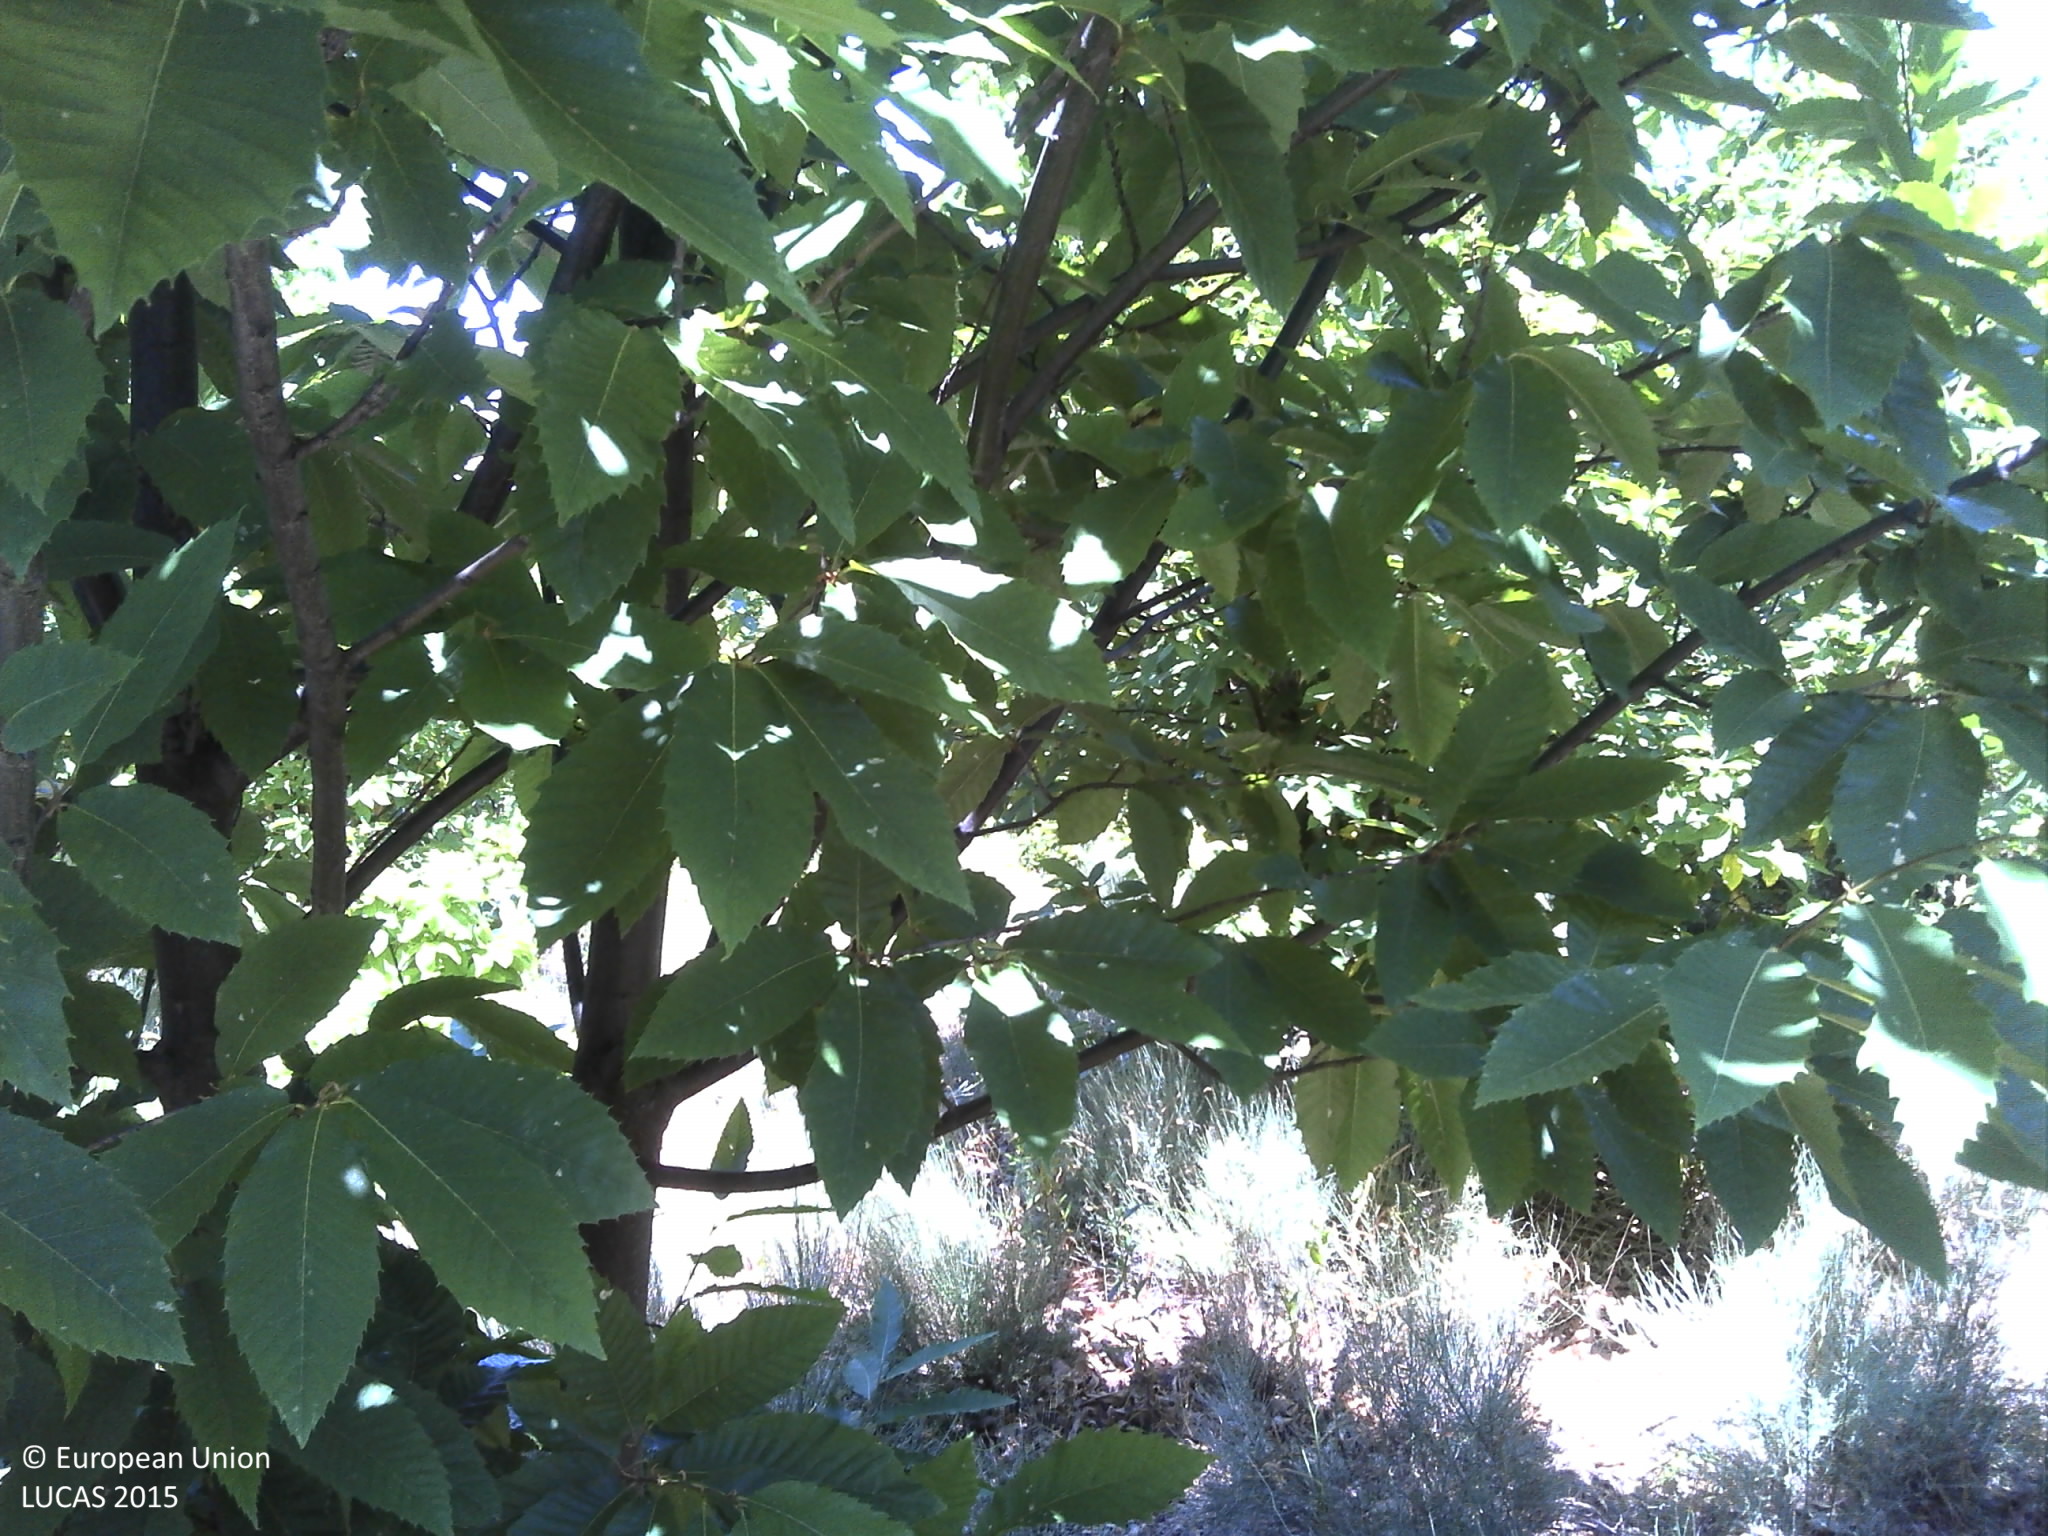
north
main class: Woodland
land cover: Broadleaved woodland
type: thermophilous deciduous forest
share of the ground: 10 - 25 %
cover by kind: shrubs 80 %, broadleaved forest trees 20 %
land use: Forestry
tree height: < 5 m
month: June
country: PT
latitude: 41.0489
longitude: -6.9409
